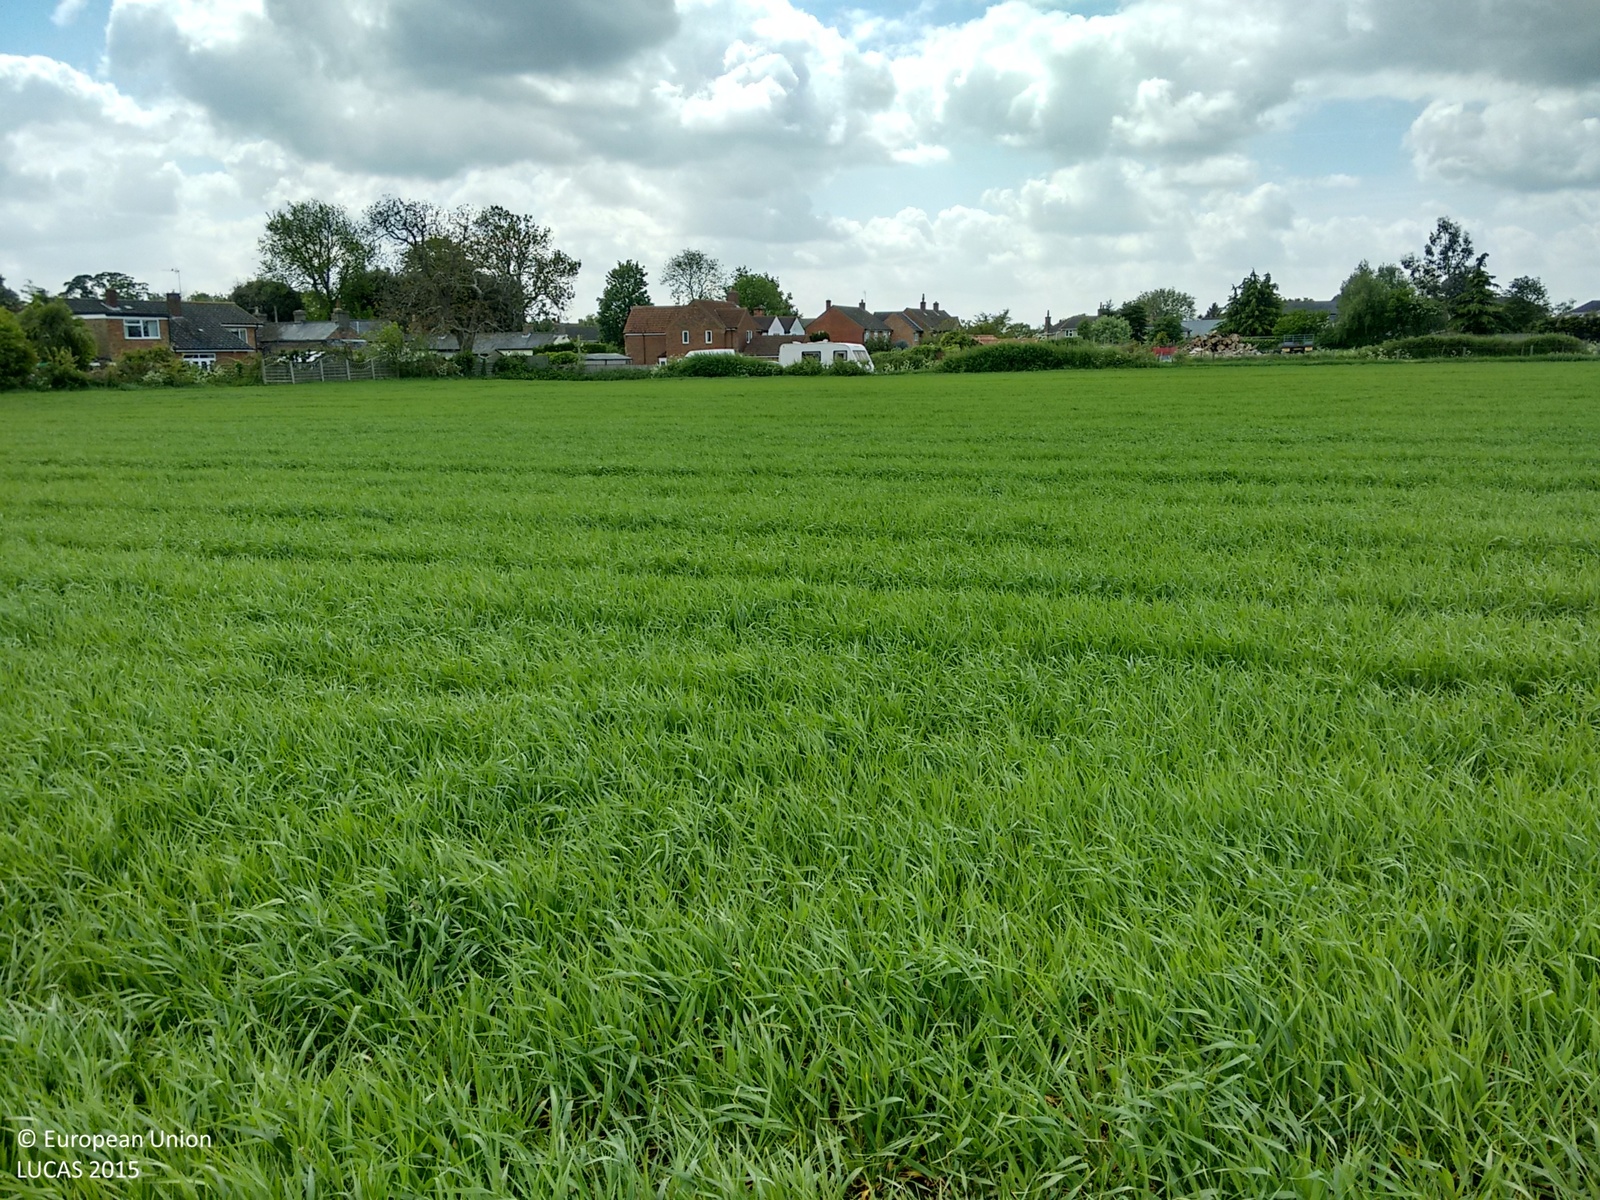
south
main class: Cropland
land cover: Barley
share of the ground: > 75 %
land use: Agriculture (excluding fallow land and kitchen gardens)
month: May
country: GB
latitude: 52.0739
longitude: -0.2926
